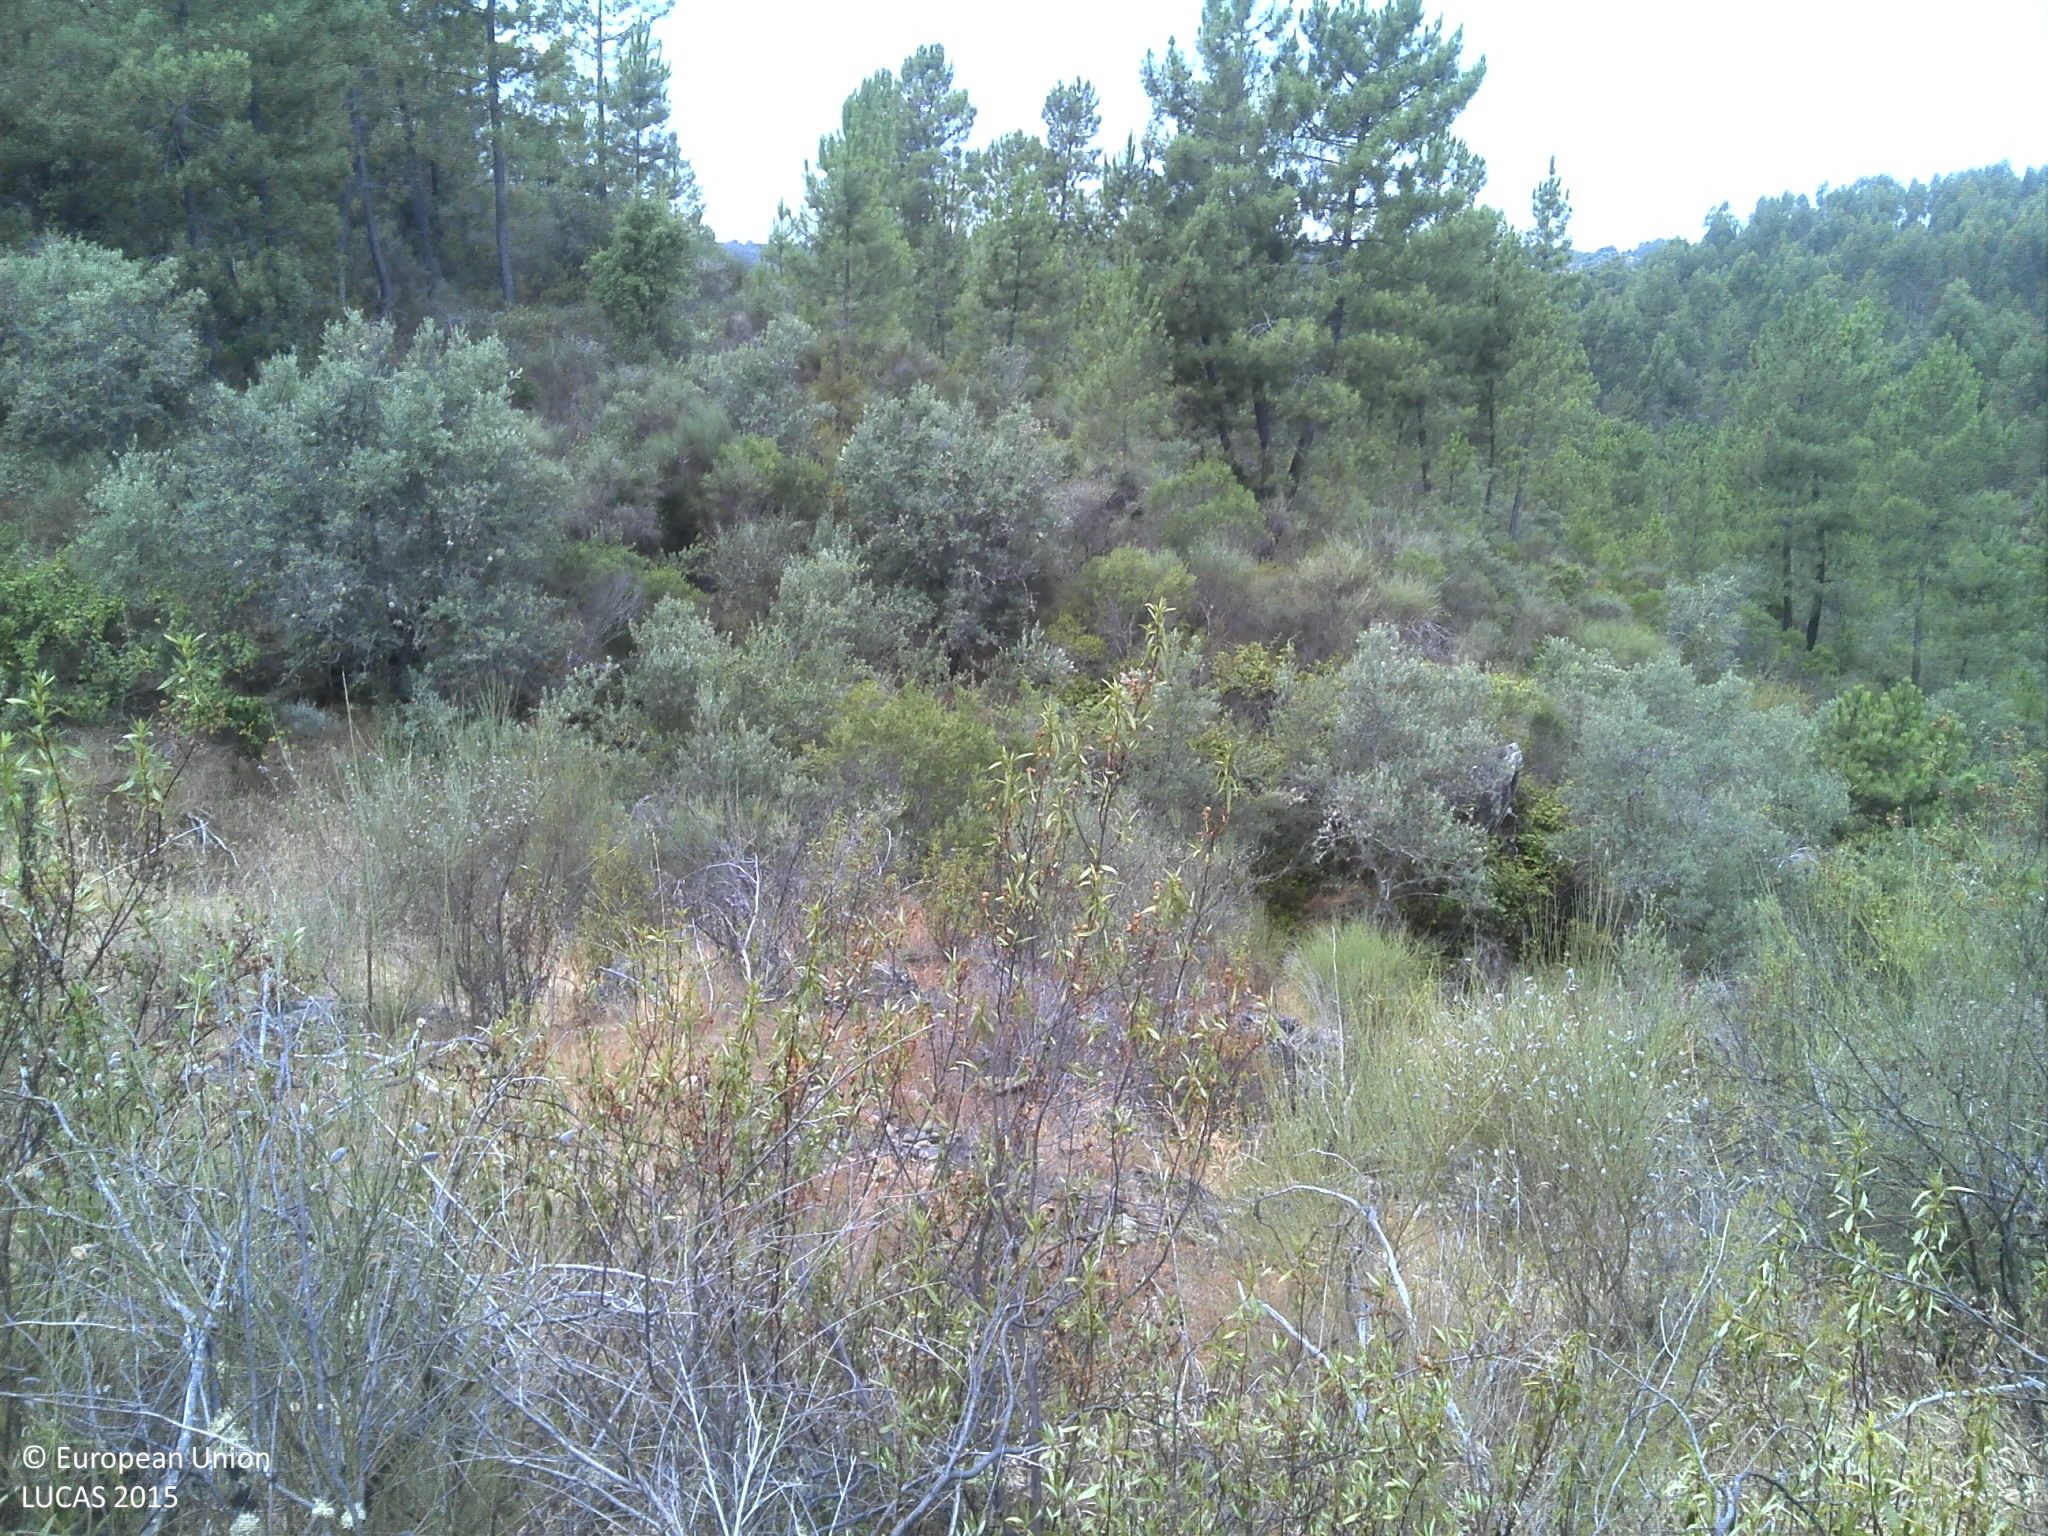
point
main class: Woodland
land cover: Pine dominated coniferous woodland
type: coniferous forest of the mediterranean region
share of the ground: 25 - 50 %
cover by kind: coniferous forest trees 45 %, shrubs 40 %, herbaceous plants 5 %, unconsolidated bare surface 5 %
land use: Forestry
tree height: > 5 m
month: July
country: PT
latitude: 39.8465
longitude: -7.3820
